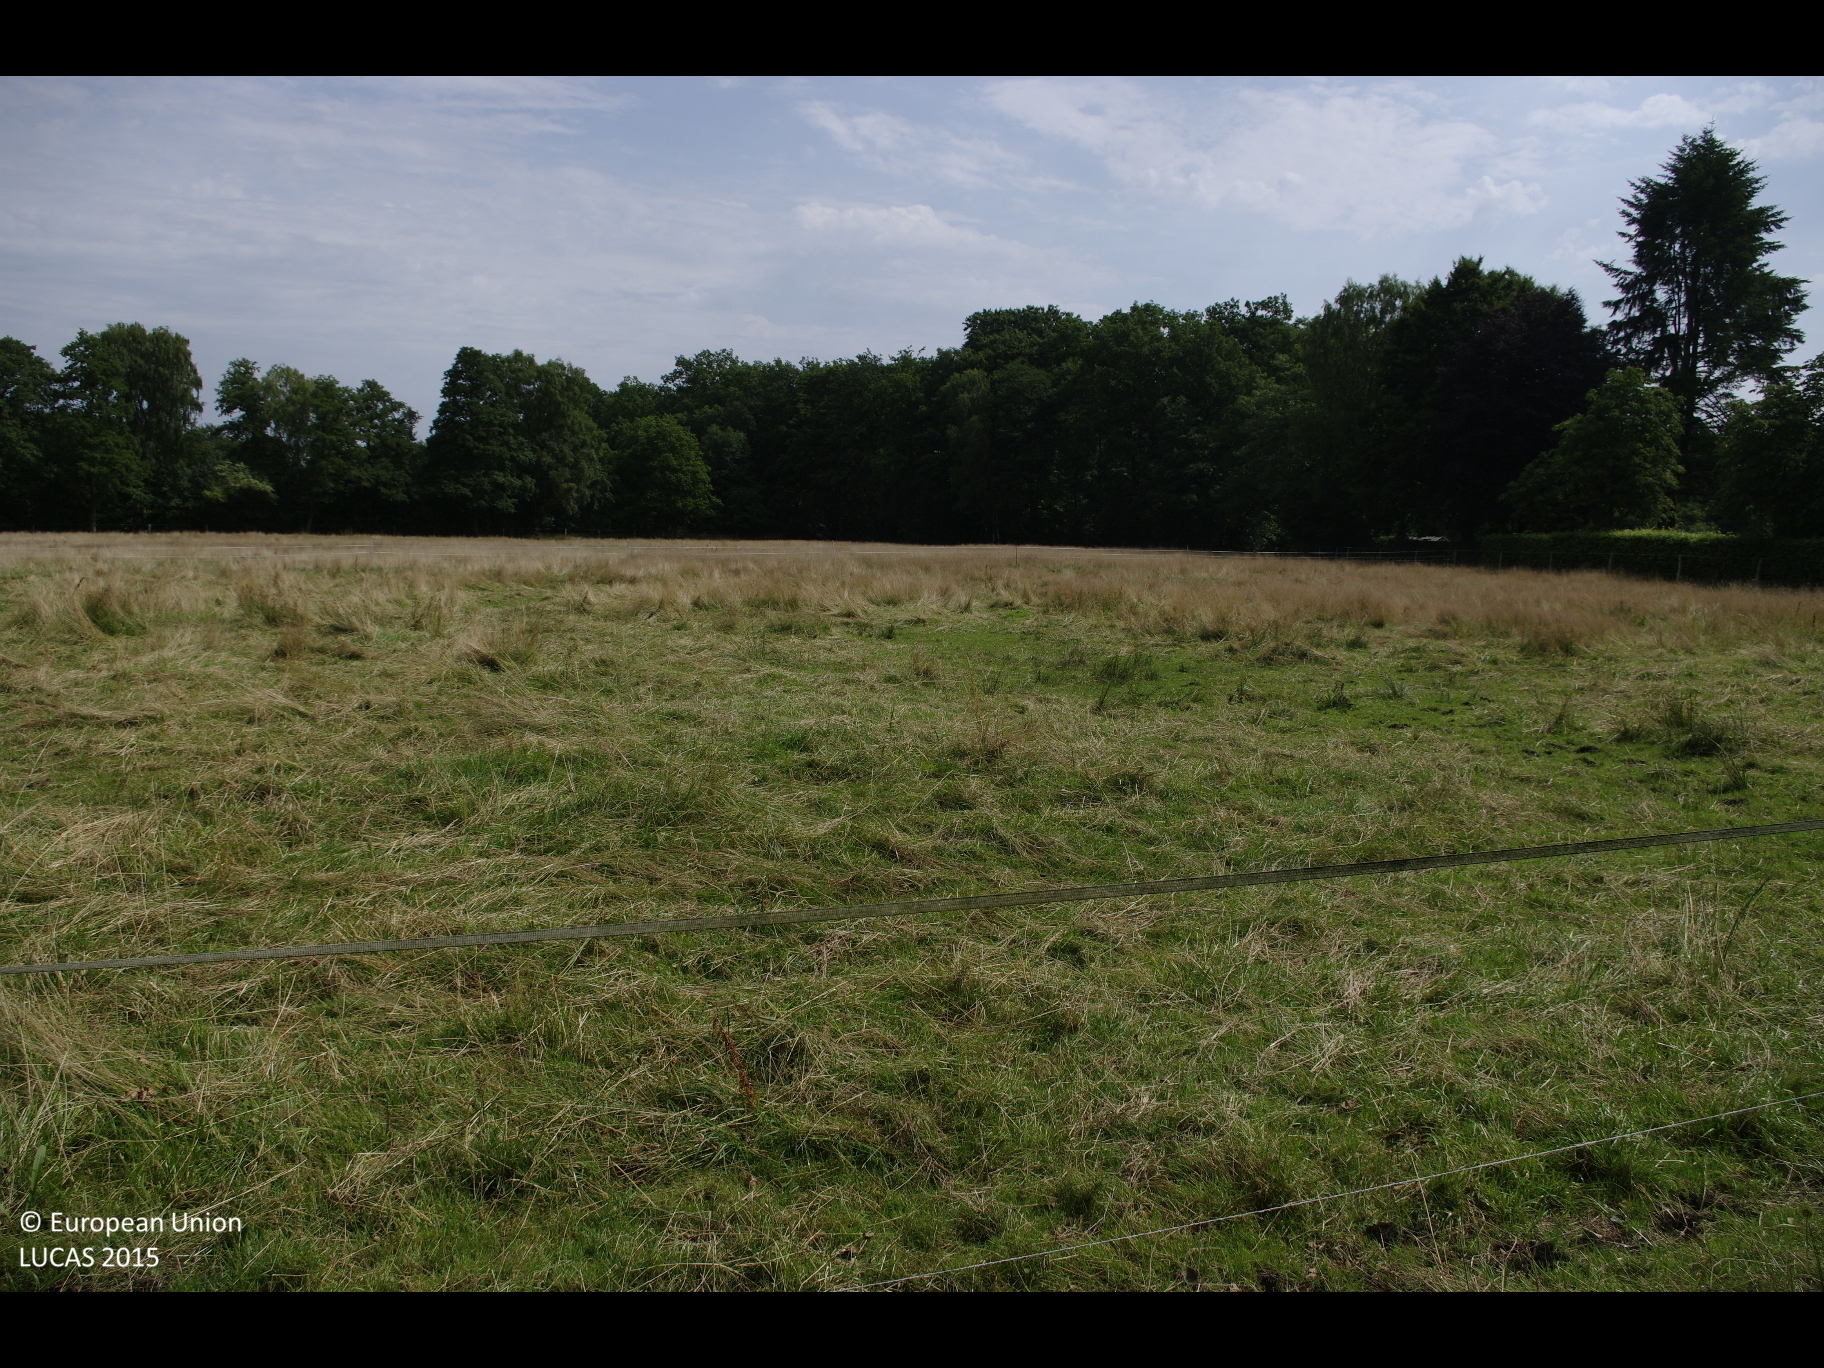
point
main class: Grassland
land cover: Grassland without tree/shrub cover
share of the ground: > 75 %
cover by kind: herbaceous plants 100 %
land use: Agriculture (excluding fallow land and kitchen gardens)
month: August
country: DE
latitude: 53.2581
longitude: 9.8652
